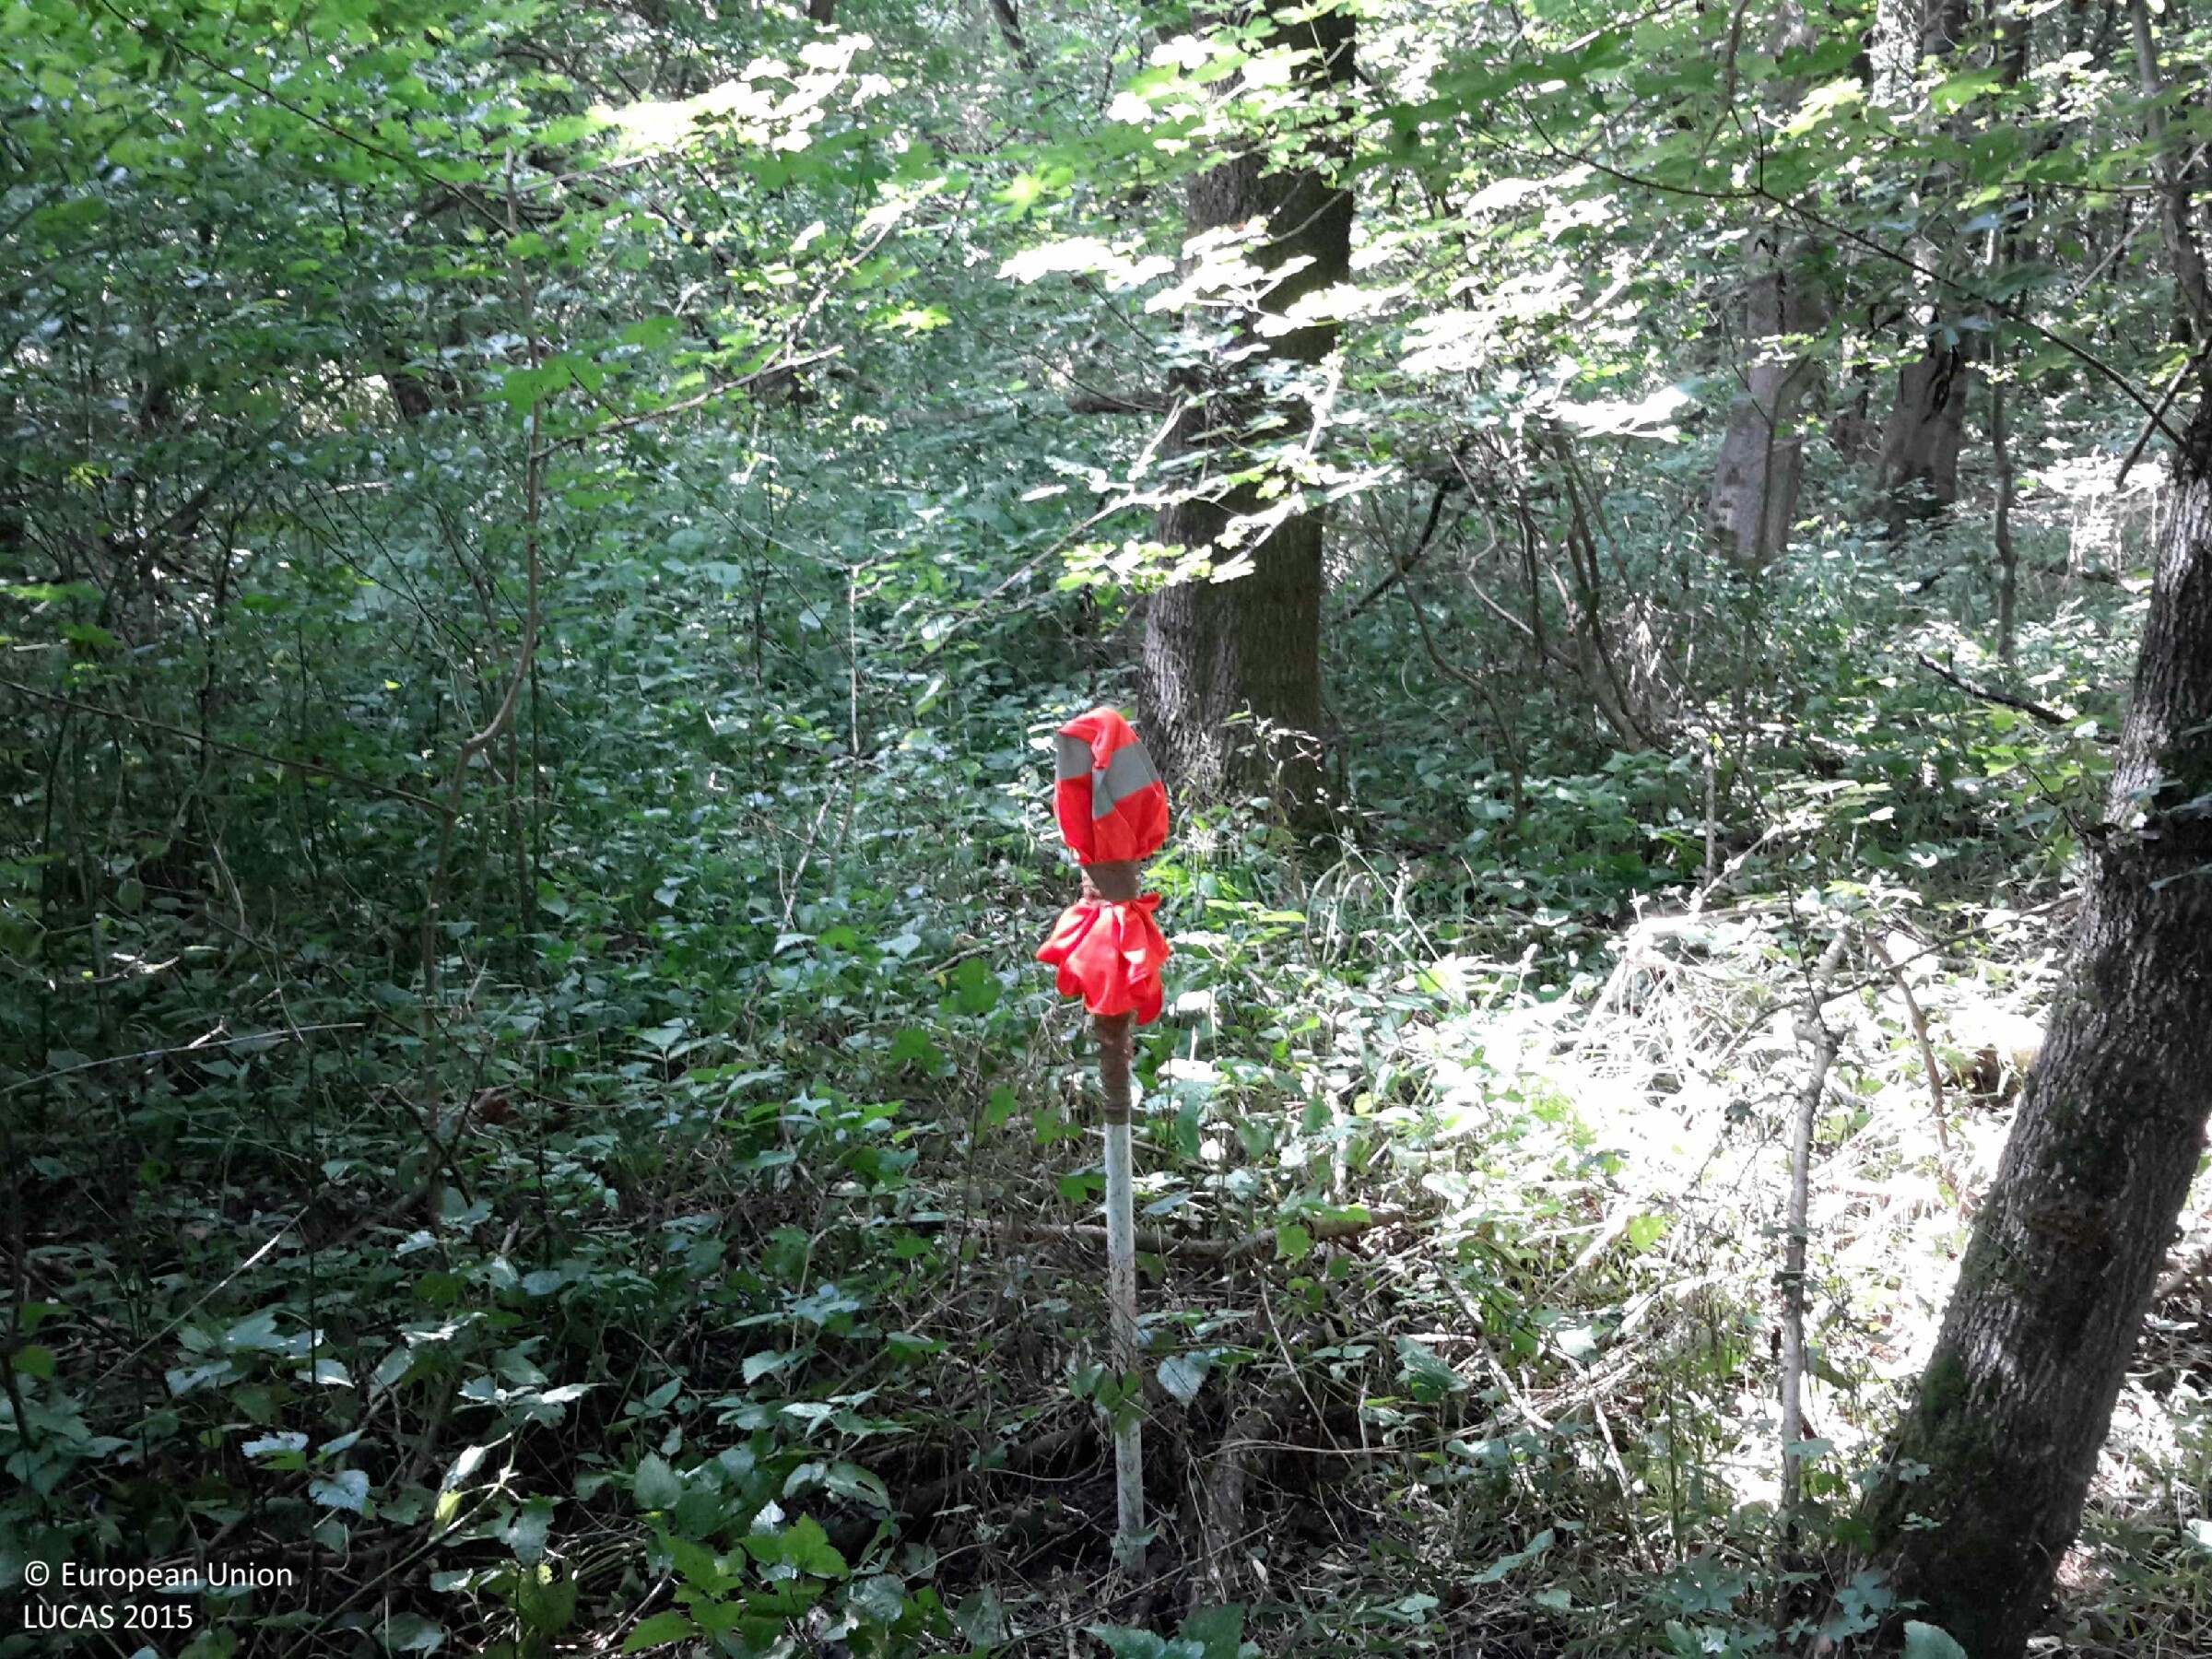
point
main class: Woodland
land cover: Broadleaved woodland
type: mesophytic deciduous forest
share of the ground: > 75 %
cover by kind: broadleaved forest trees 90 %, shrubs 5 %, herbaceous plants 5 %
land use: Forestry
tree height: > 5 m
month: July
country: HU
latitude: 47.4397
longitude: 17.0202
